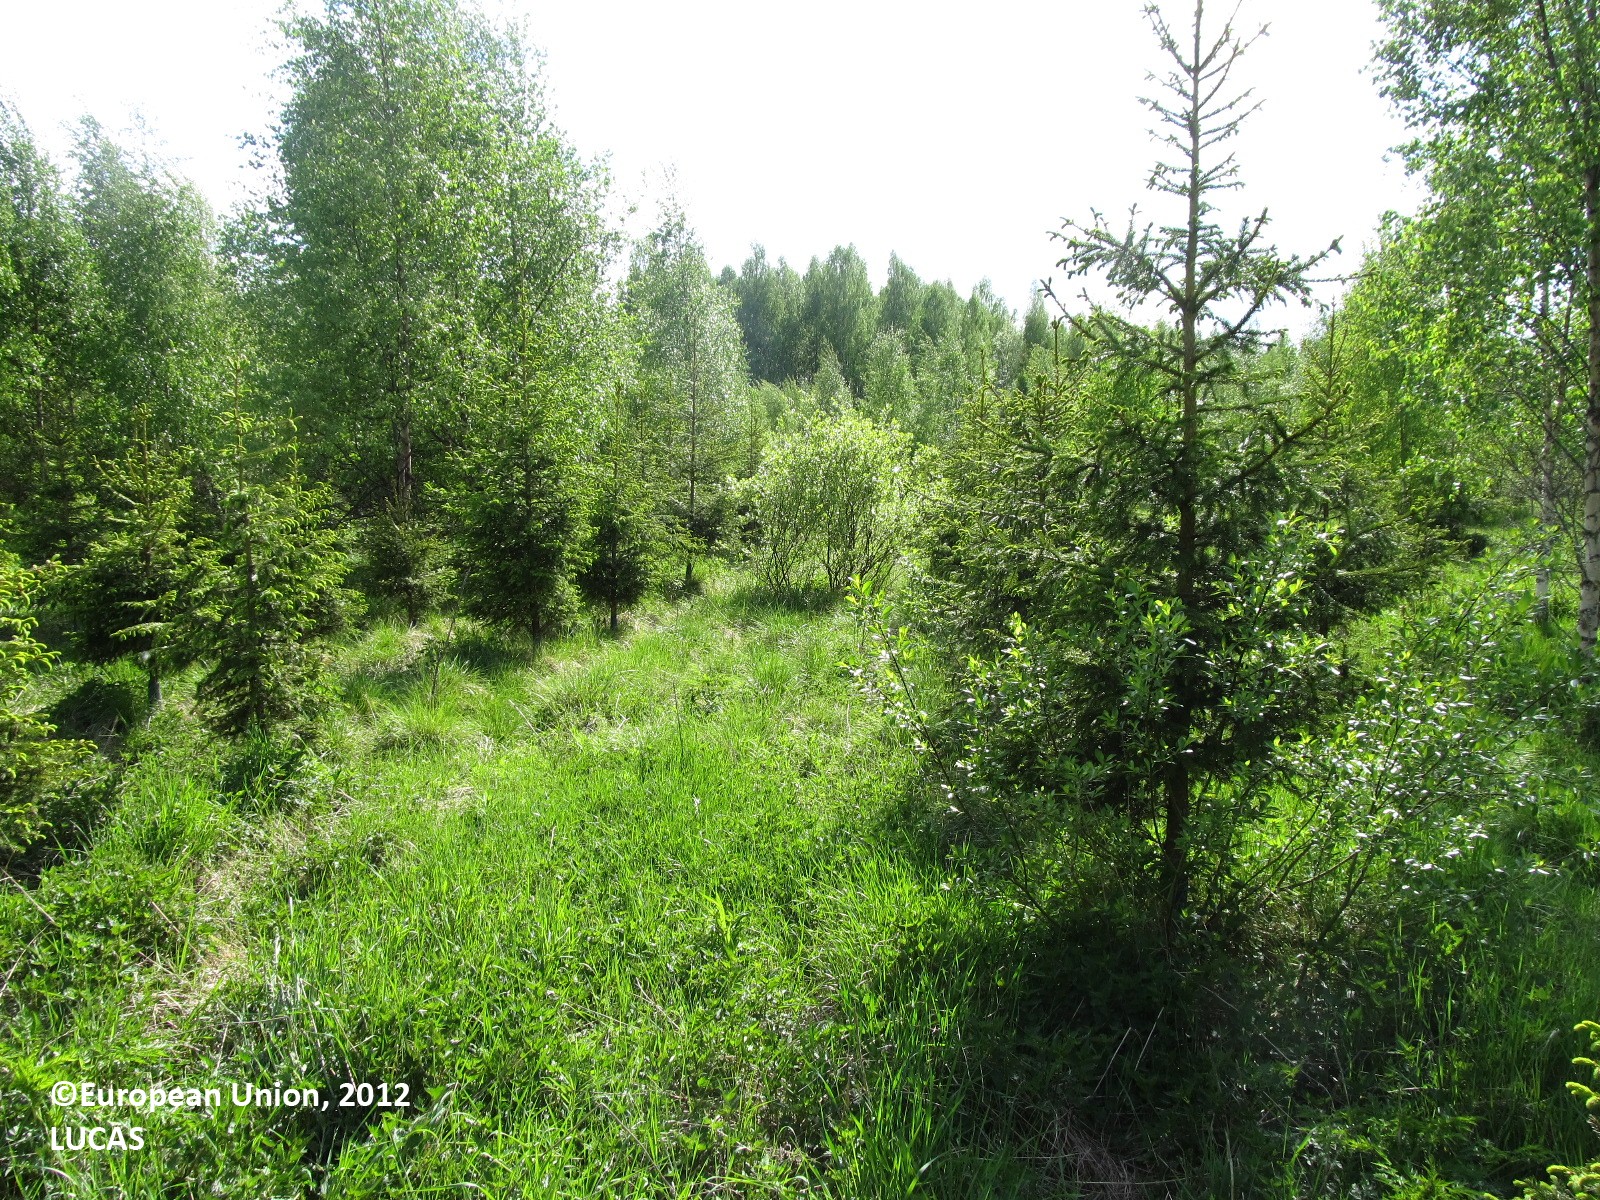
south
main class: Woodland
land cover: Spruce dominated coniferous woodland
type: boreal forest
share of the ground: 10 - 25 %
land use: Forestry
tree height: < 5 m
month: June
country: FI
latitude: 62.5294
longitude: 28.6469
